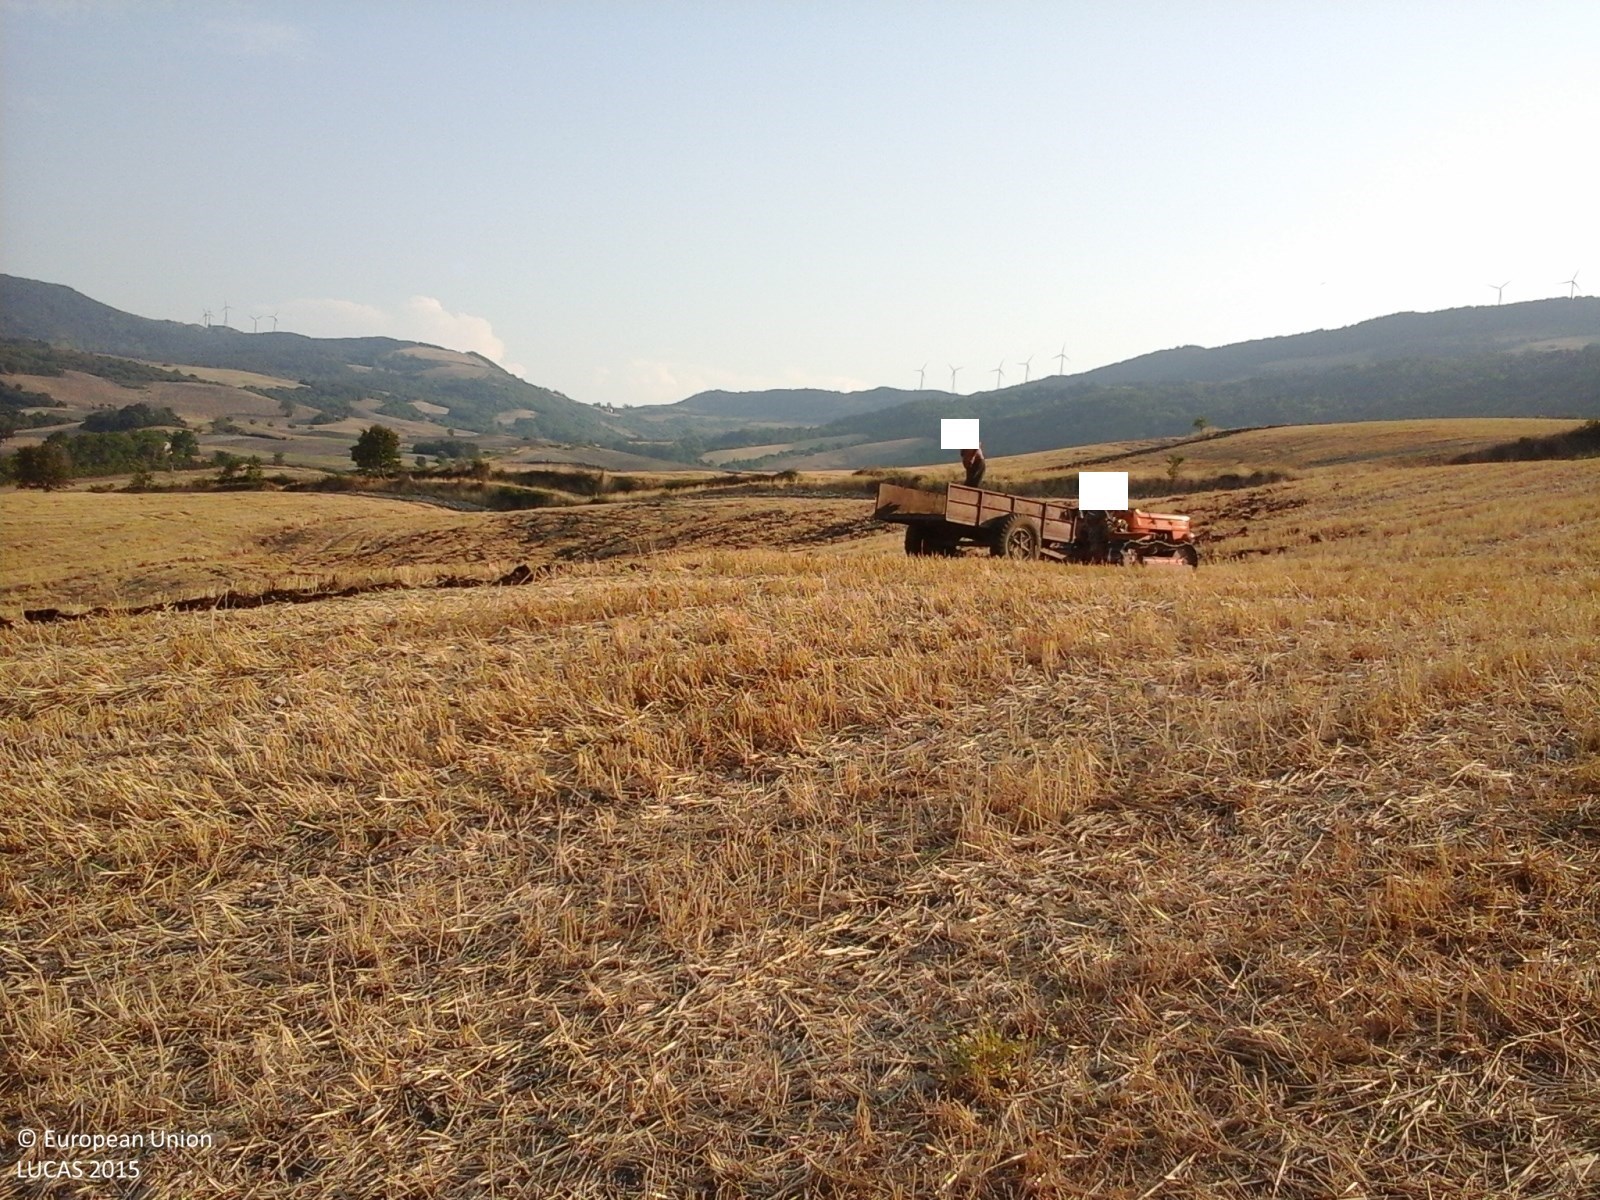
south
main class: Cropland
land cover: Durum wheat
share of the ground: > 75 %
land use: Agriculture (excluding fallow land and kitchen gardens)
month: August
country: IT
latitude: 41.4013
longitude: 15.1376
